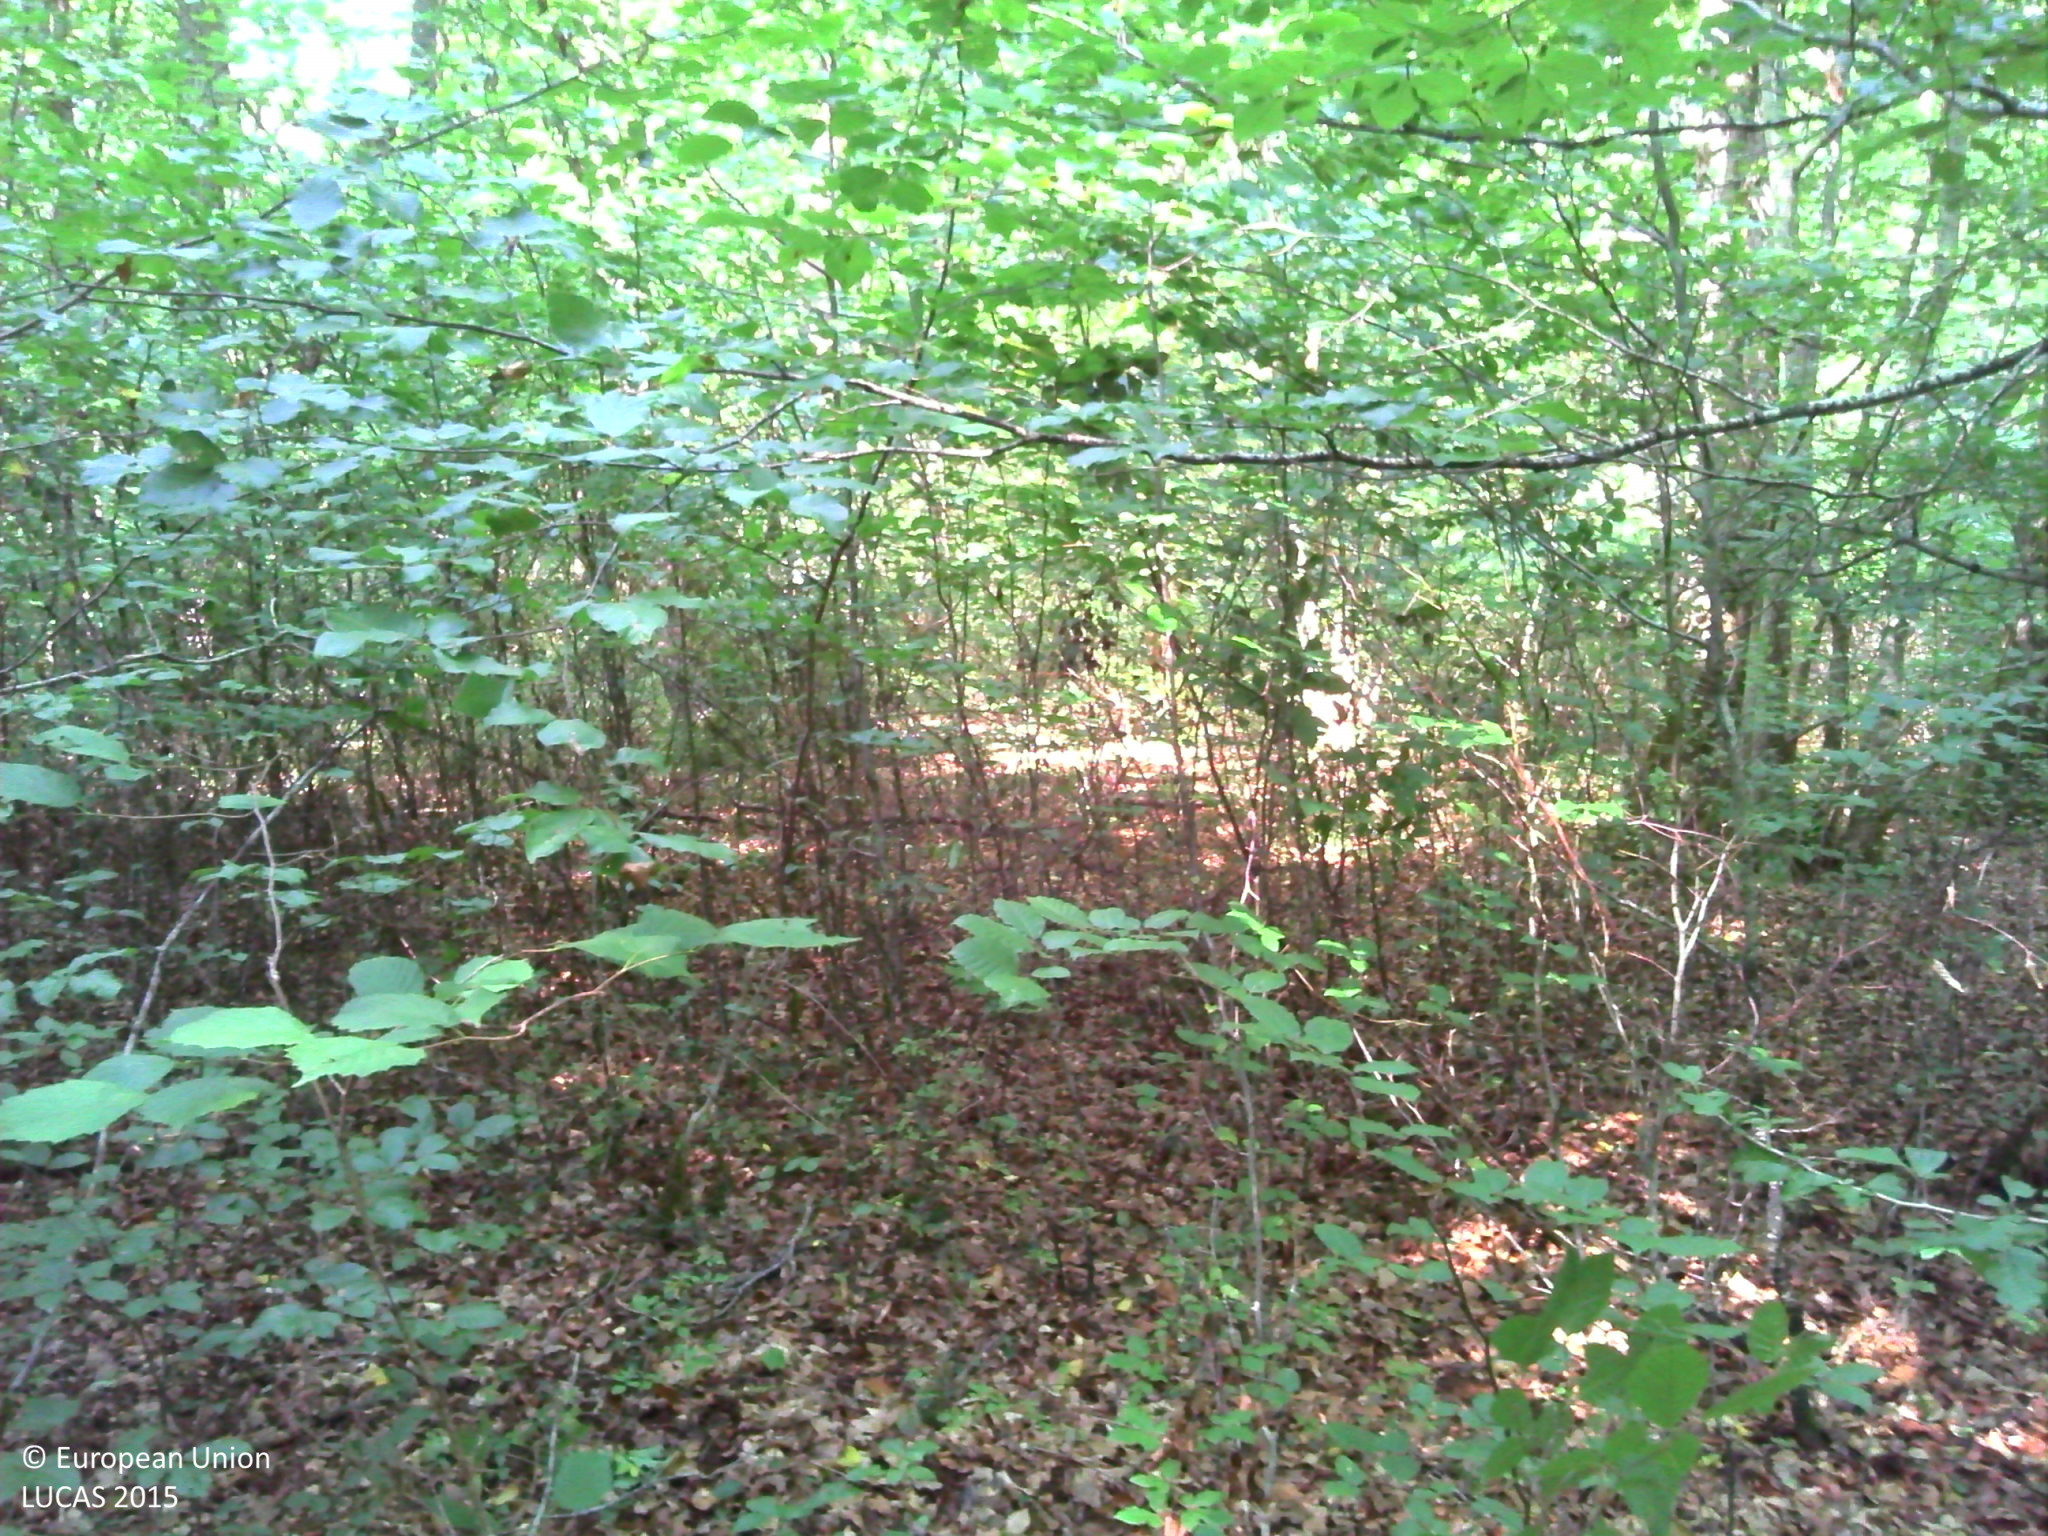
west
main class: Woodland
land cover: Broadleaved woodland
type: mesophytic deciduous forest
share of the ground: > 75 %
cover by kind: broadleaved forest trees 90 %, herbaceous plants 5 %, lichens and mosses 5 %
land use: Forestry
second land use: Amenities, museums, leisure
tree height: > 5 m
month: August
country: FR
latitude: 47.8638
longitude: 4.7454
